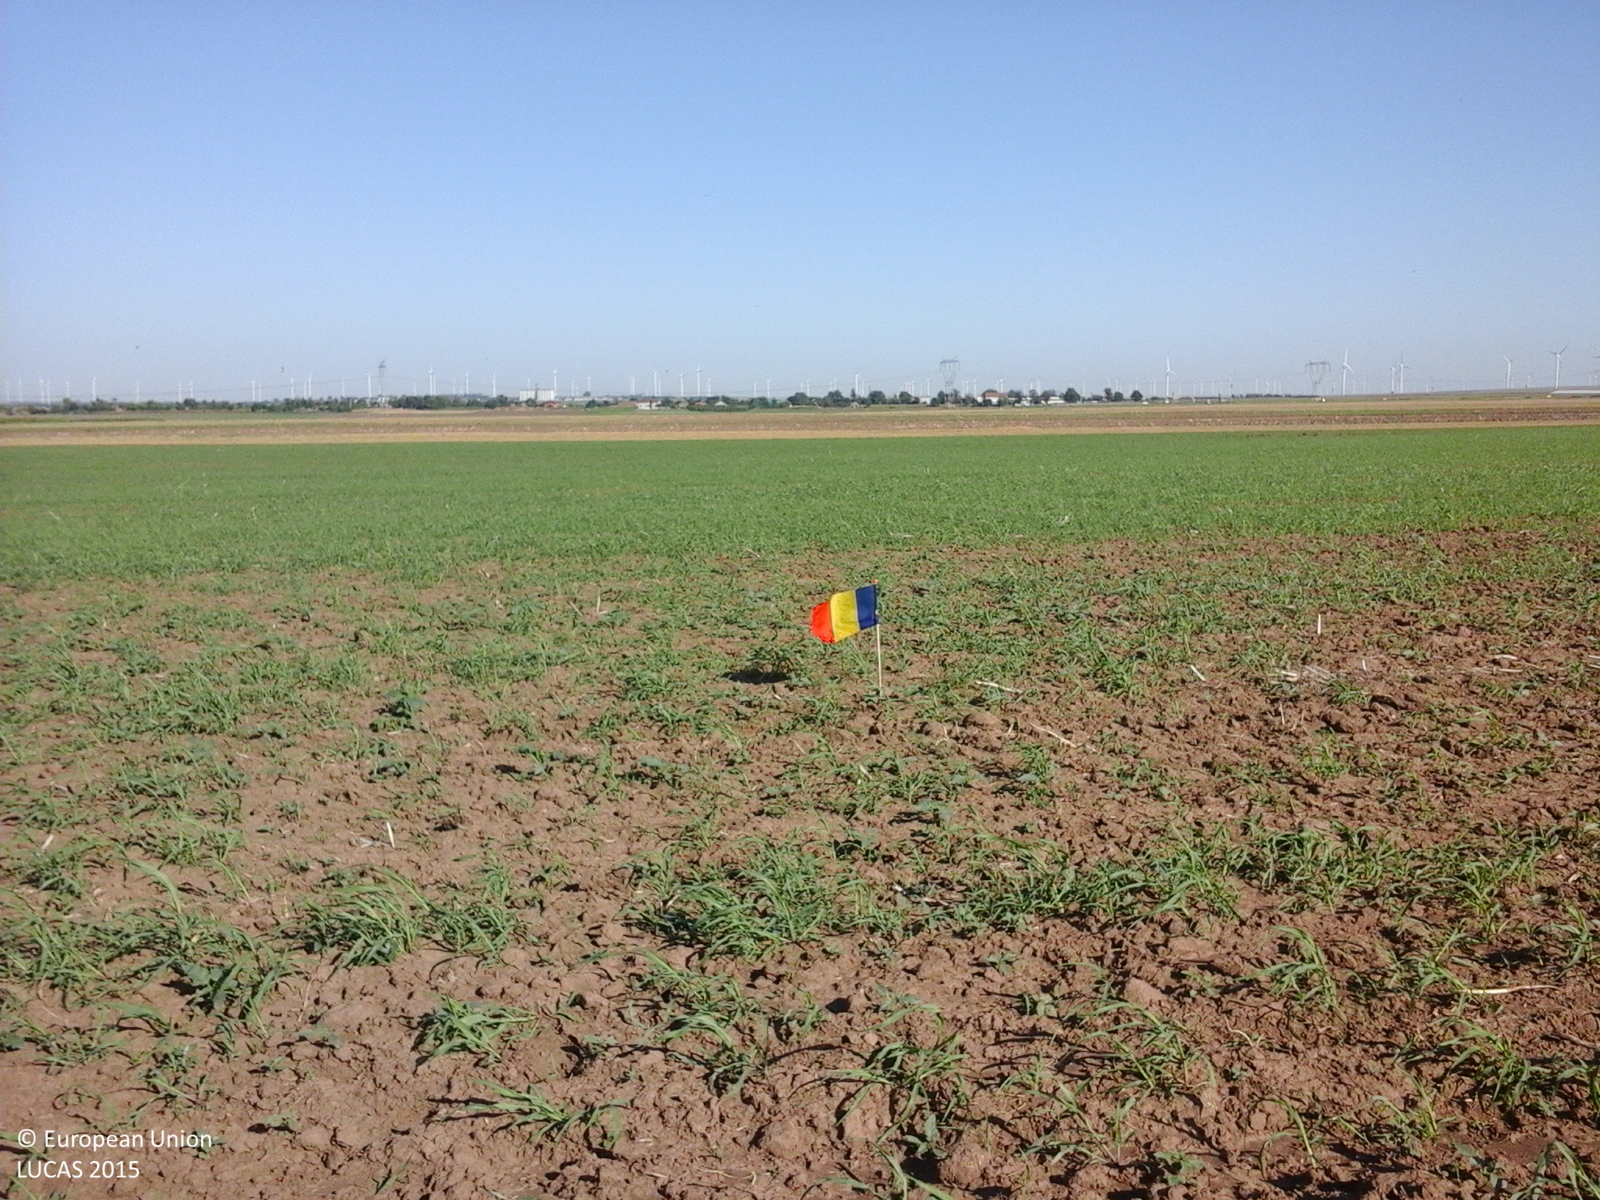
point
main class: Grassland
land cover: Spontaneously vegetated surfaces
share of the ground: > 75 %
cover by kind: herbaceous plants 100 %
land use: Agriculture (excluding fallow land and kitchen gardens)
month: August
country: RO
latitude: 44.5496
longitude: 28.6192
